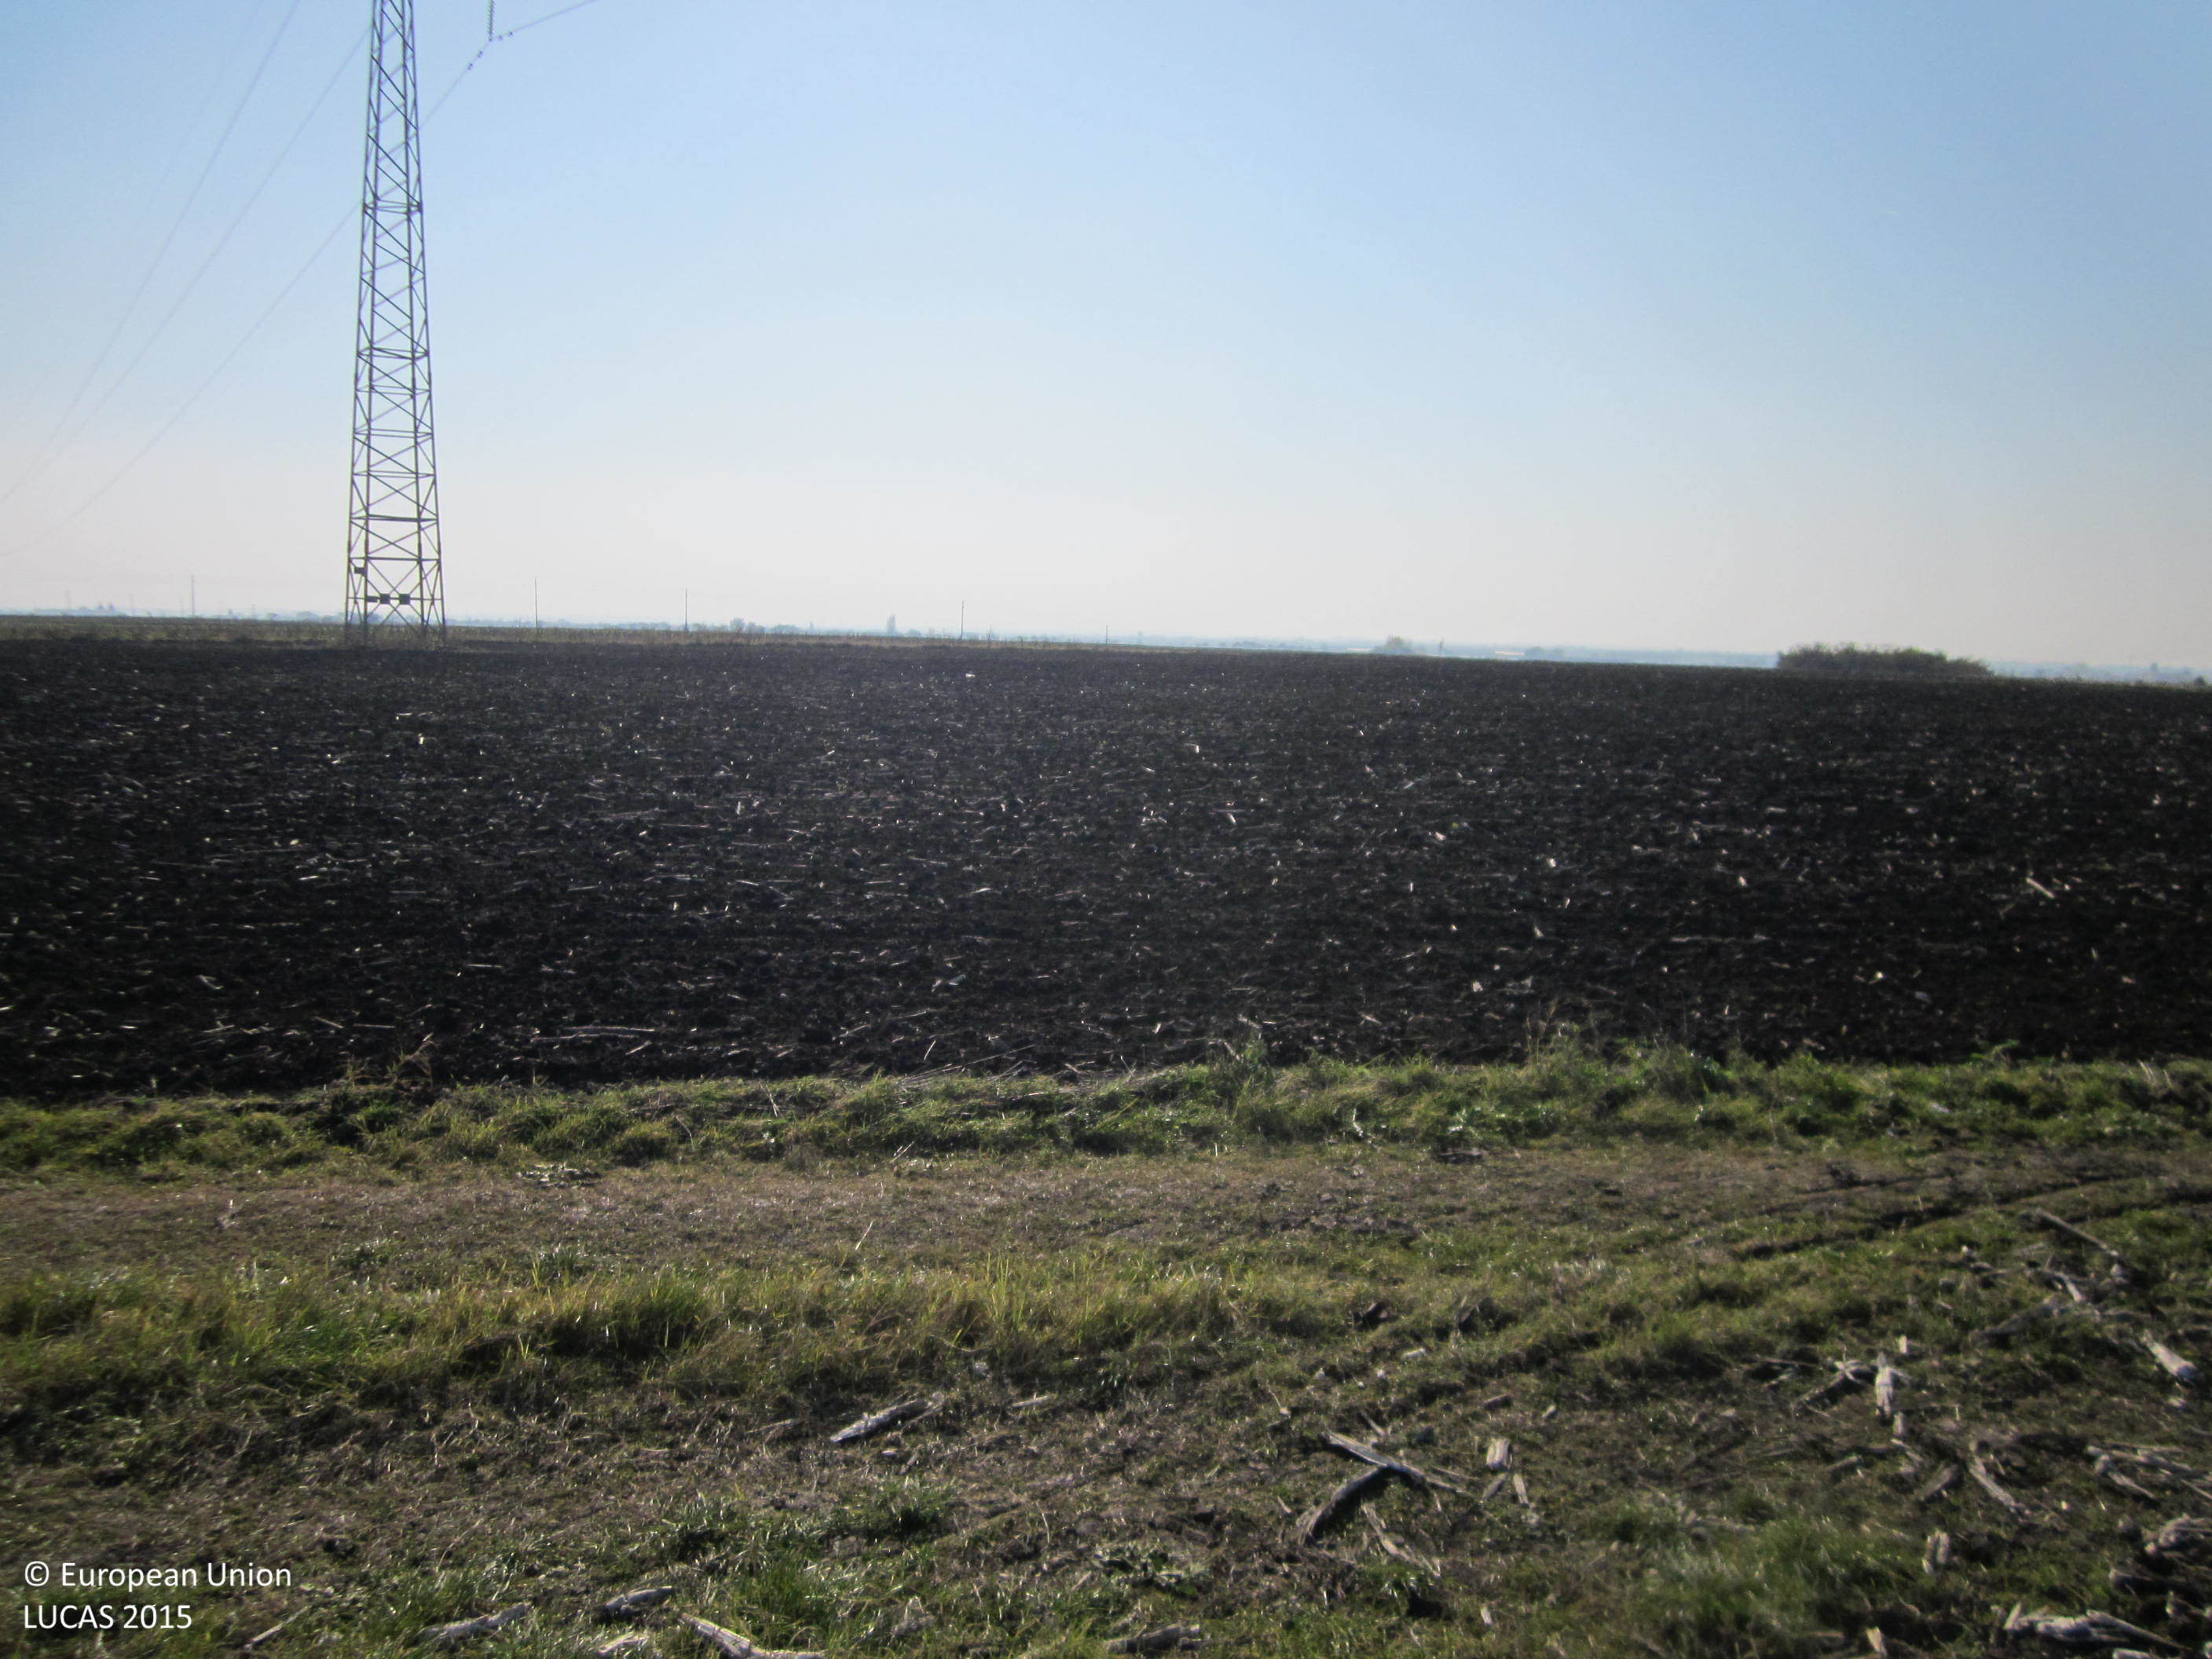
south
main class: Cropland
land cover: Sunflower
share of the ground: < 10 %
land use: Agriculture (excluding fallow land and kitchen gardens)
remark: Harvested field
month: November
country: BG
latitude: 42.3757
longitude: 24.7366
